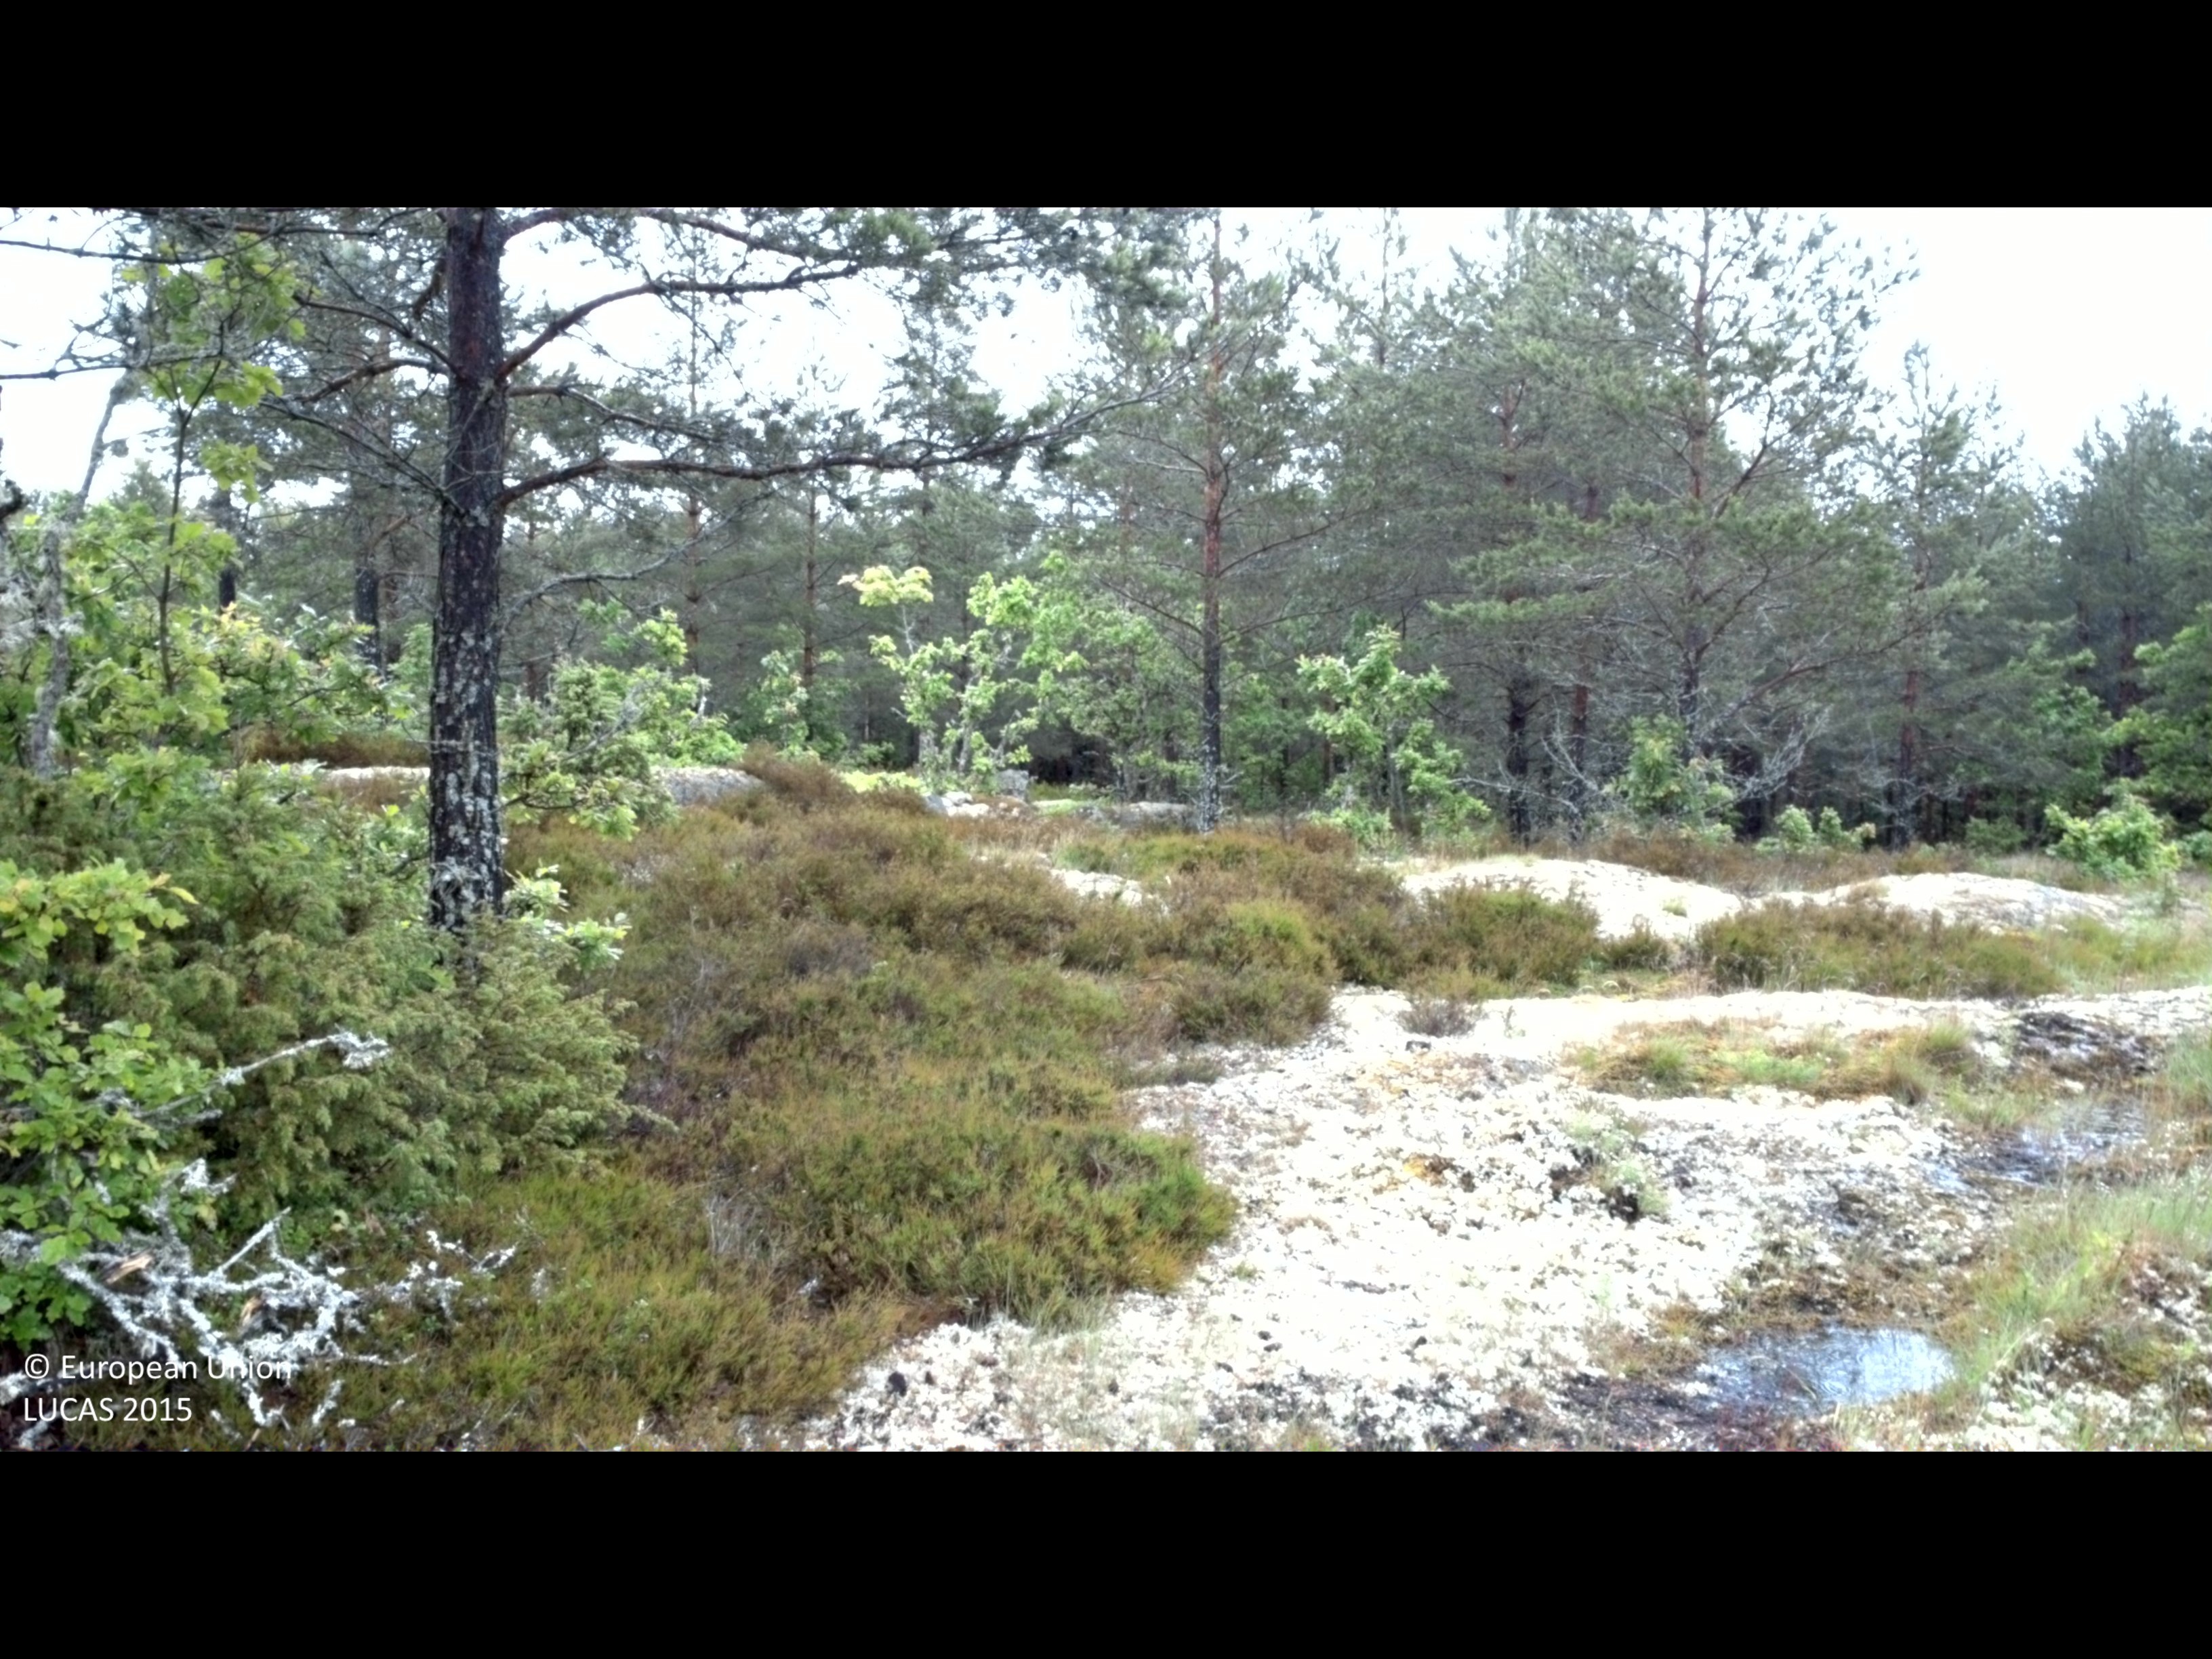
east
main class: Woodland
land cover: Pine dominated mixed woodland
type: boreal forest
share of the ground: 10 - 25 %
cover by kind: shrubs 50 %, lichens and mosses 25 %, coniferous forest trees 10 %, herbaceous plants 10 %, broadleaved forest trees 5 %
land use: Semi-natural and natural areas not in use
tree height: > 5 m
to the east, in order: Pine dominated mixed woodland; Pine dominated coniferous woodland; Pine dominated mixed woodland; Pine dominated coniferous woodland; Shrubland with sparse tree cover
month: June
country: SE
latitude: 57.9993
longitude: 16.3079
